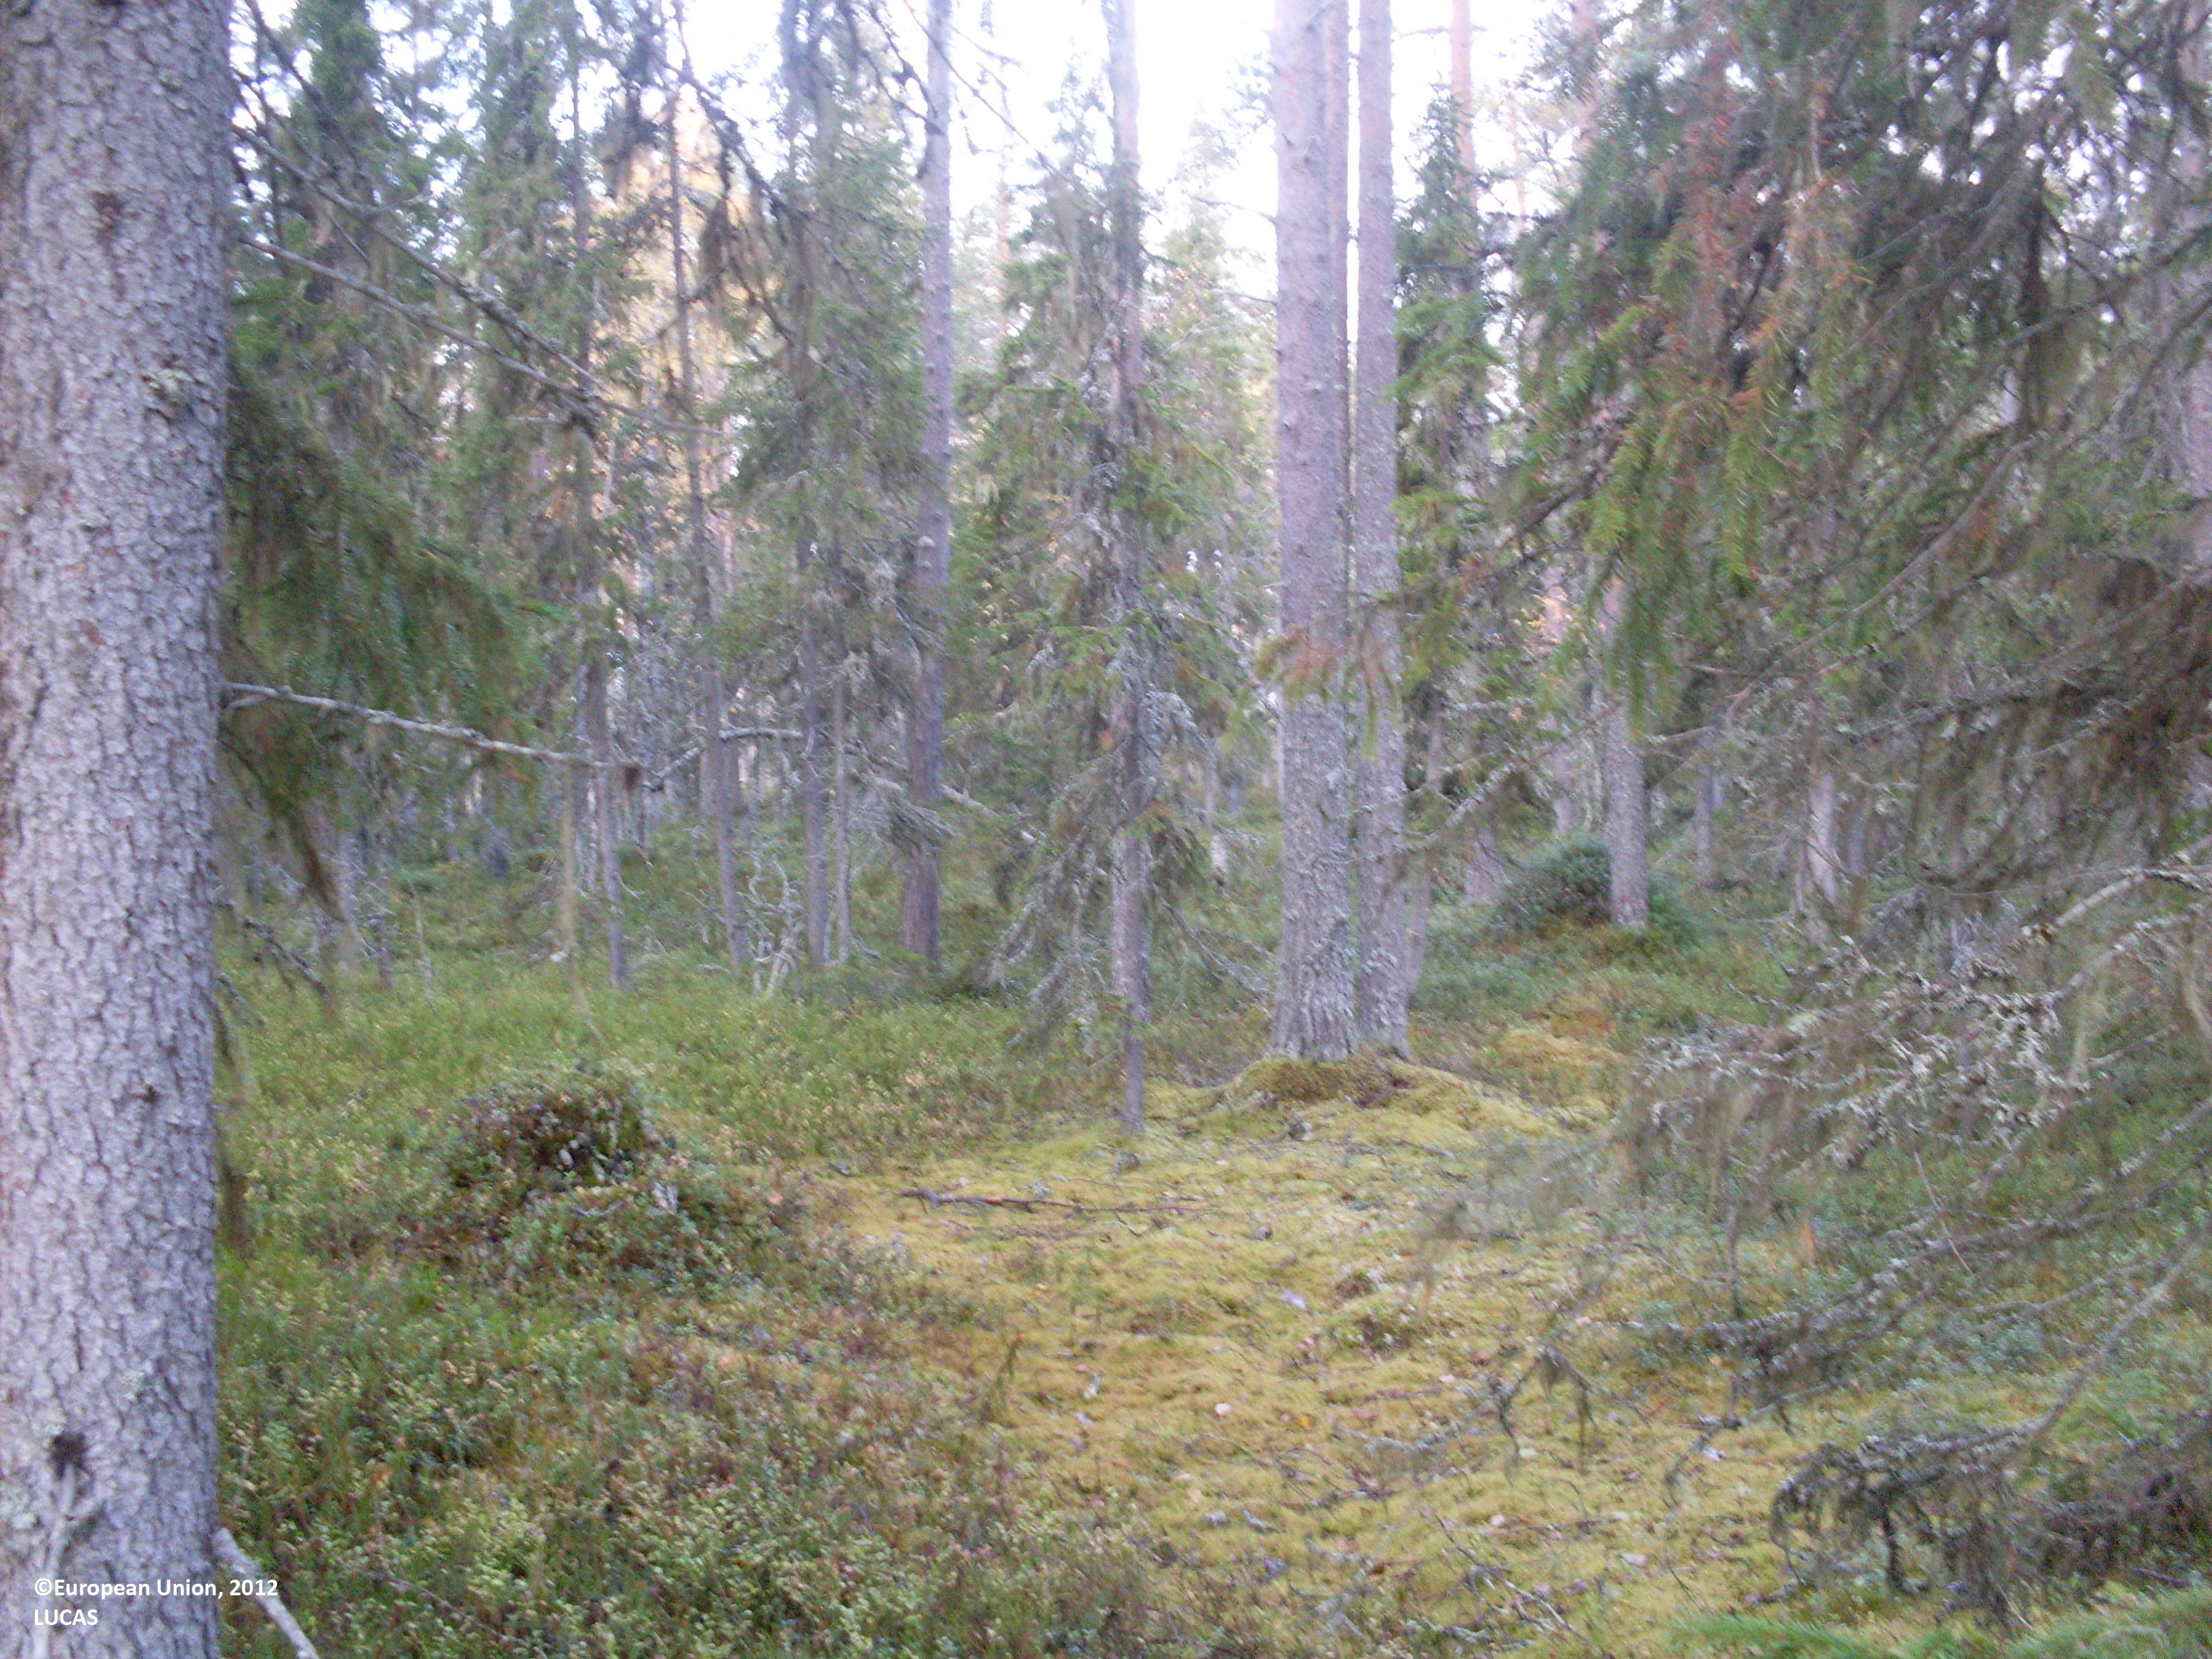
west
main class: Woodland
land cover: Pine dominated mixed woodland
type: boreal forest
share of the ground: 50 - 75 %
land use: Forestry
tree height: > 5 m
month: September
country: FI
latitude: 64.7094
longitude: 29.3151
